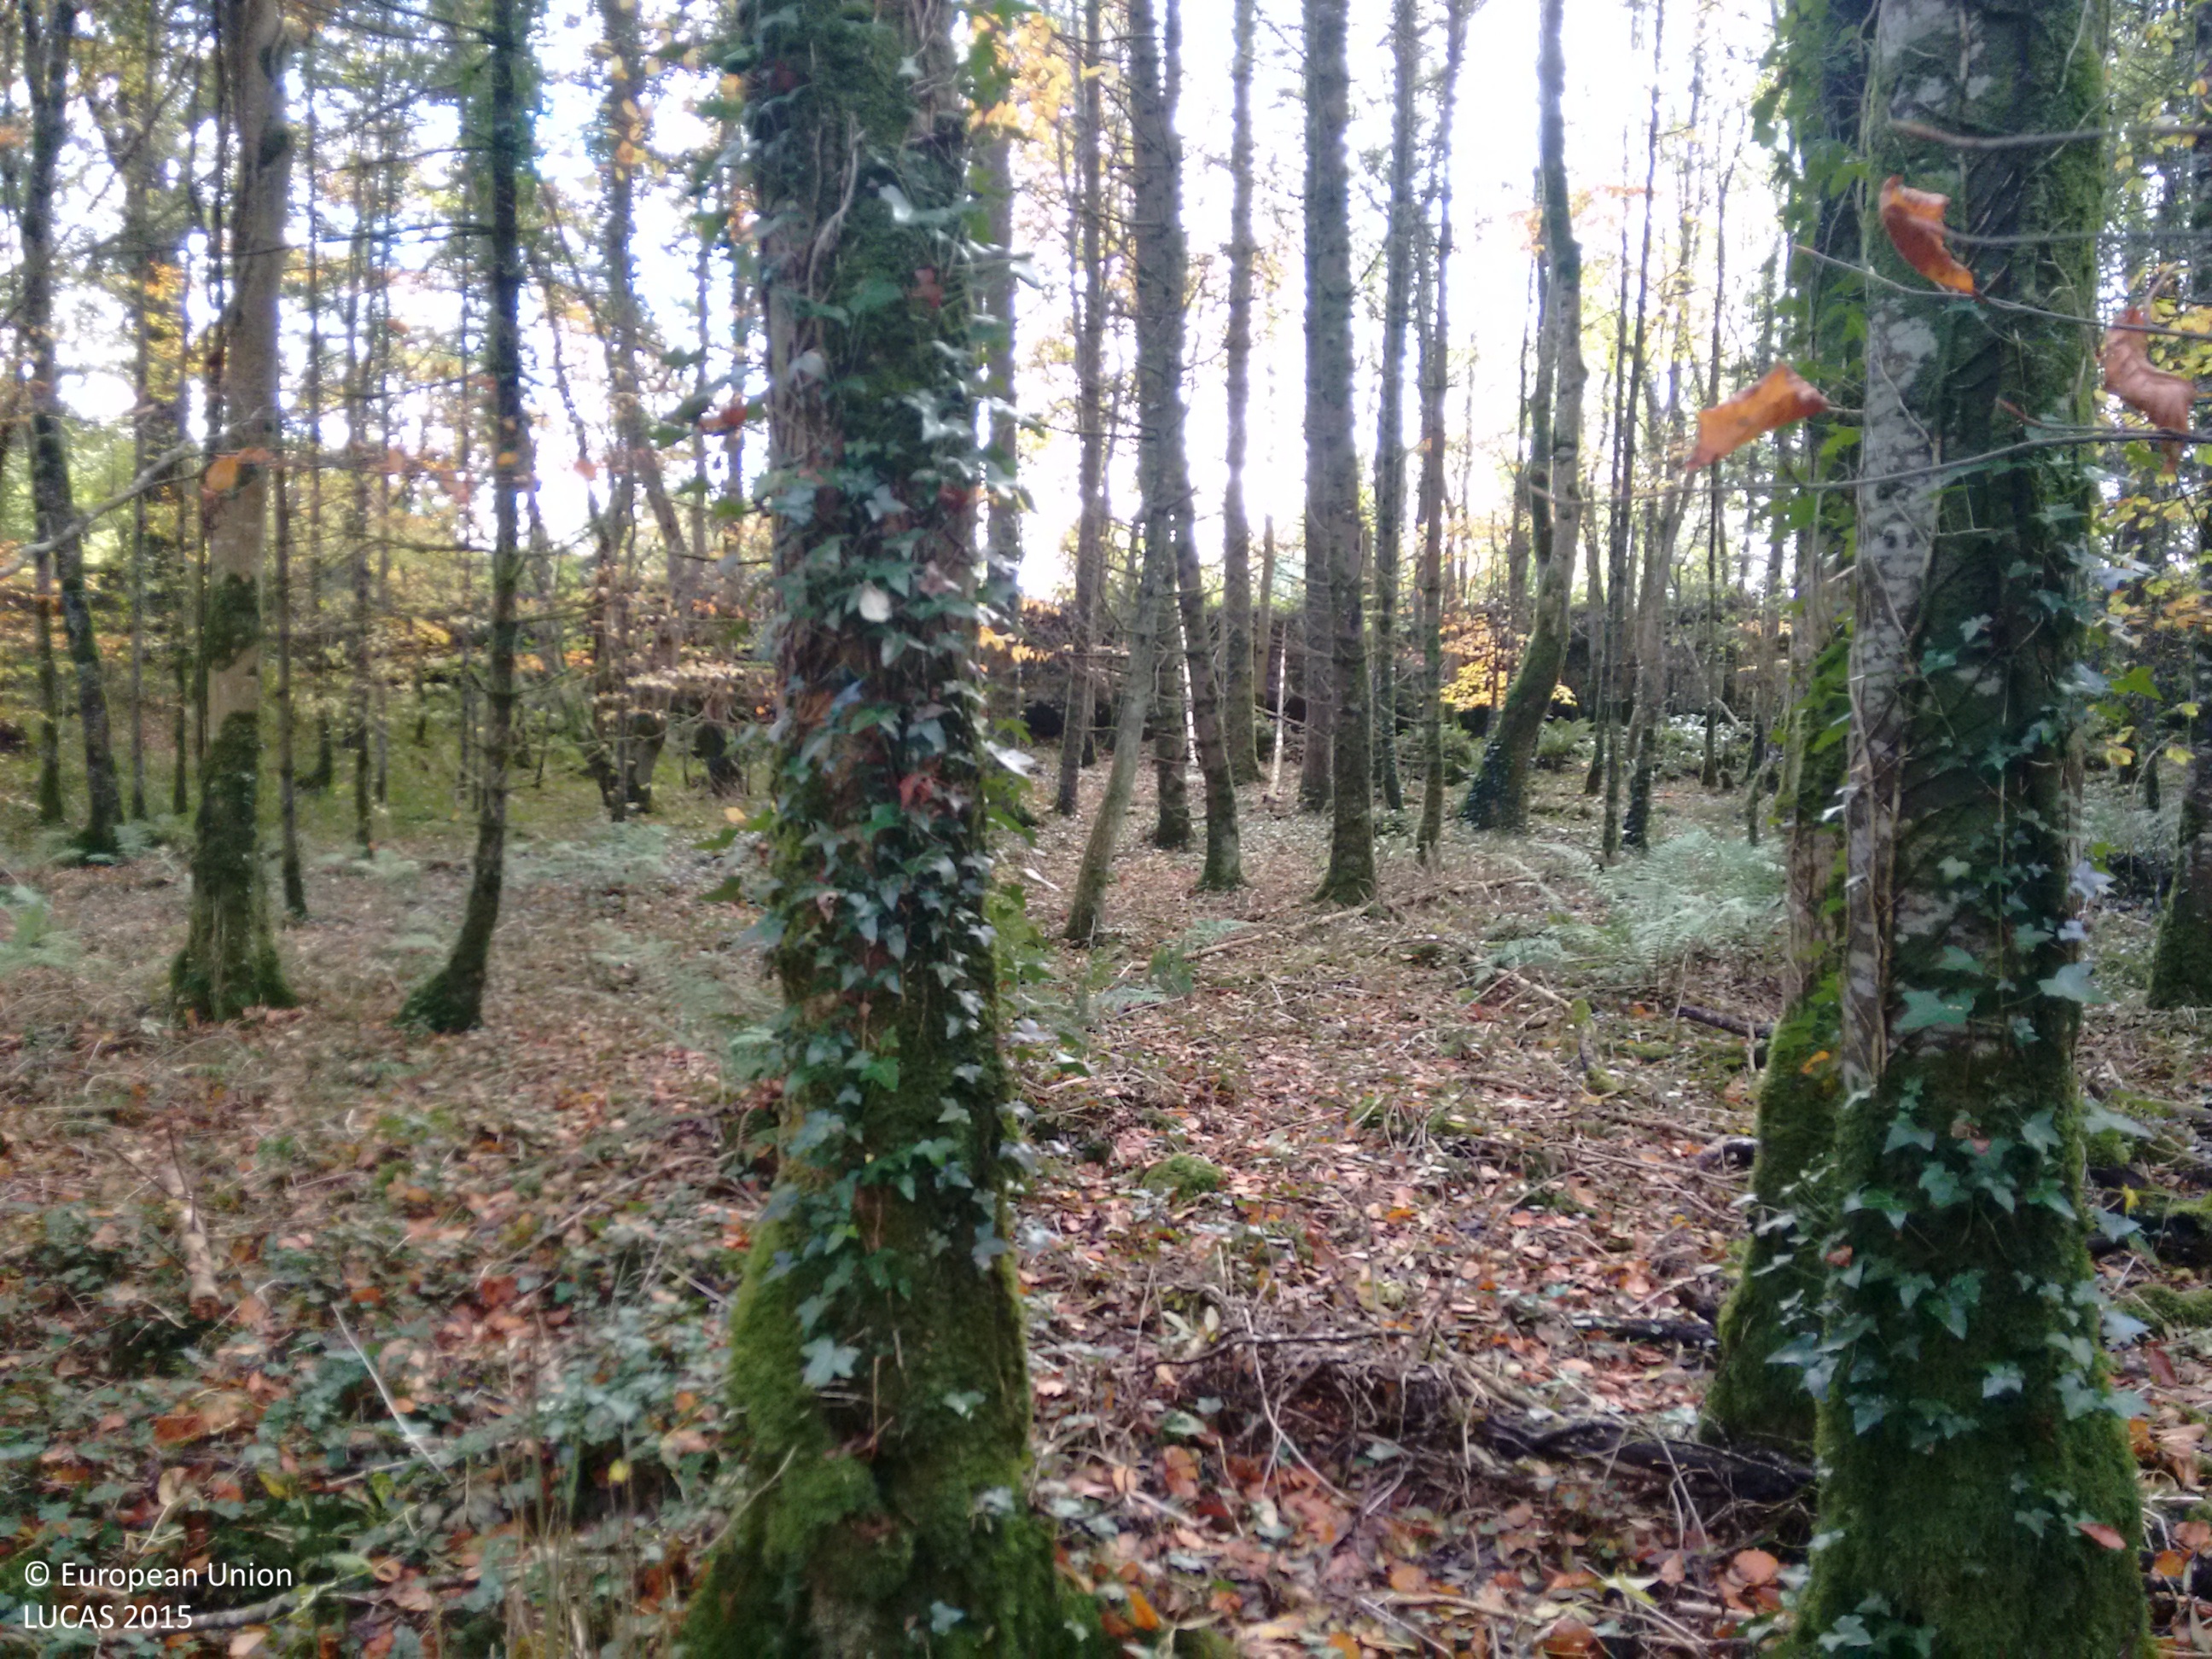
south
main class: Woodland
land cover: Broadleaved woodland
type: acidophilous oak and oak-birch forest
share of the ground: > 75 %
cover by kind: broadleaved forest trees 95 %, herbaceous plants 5 %
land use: Amenities, museums, leisure
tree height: > 5 m
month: October
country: IE
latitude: 53.9738
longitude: -8.2498
